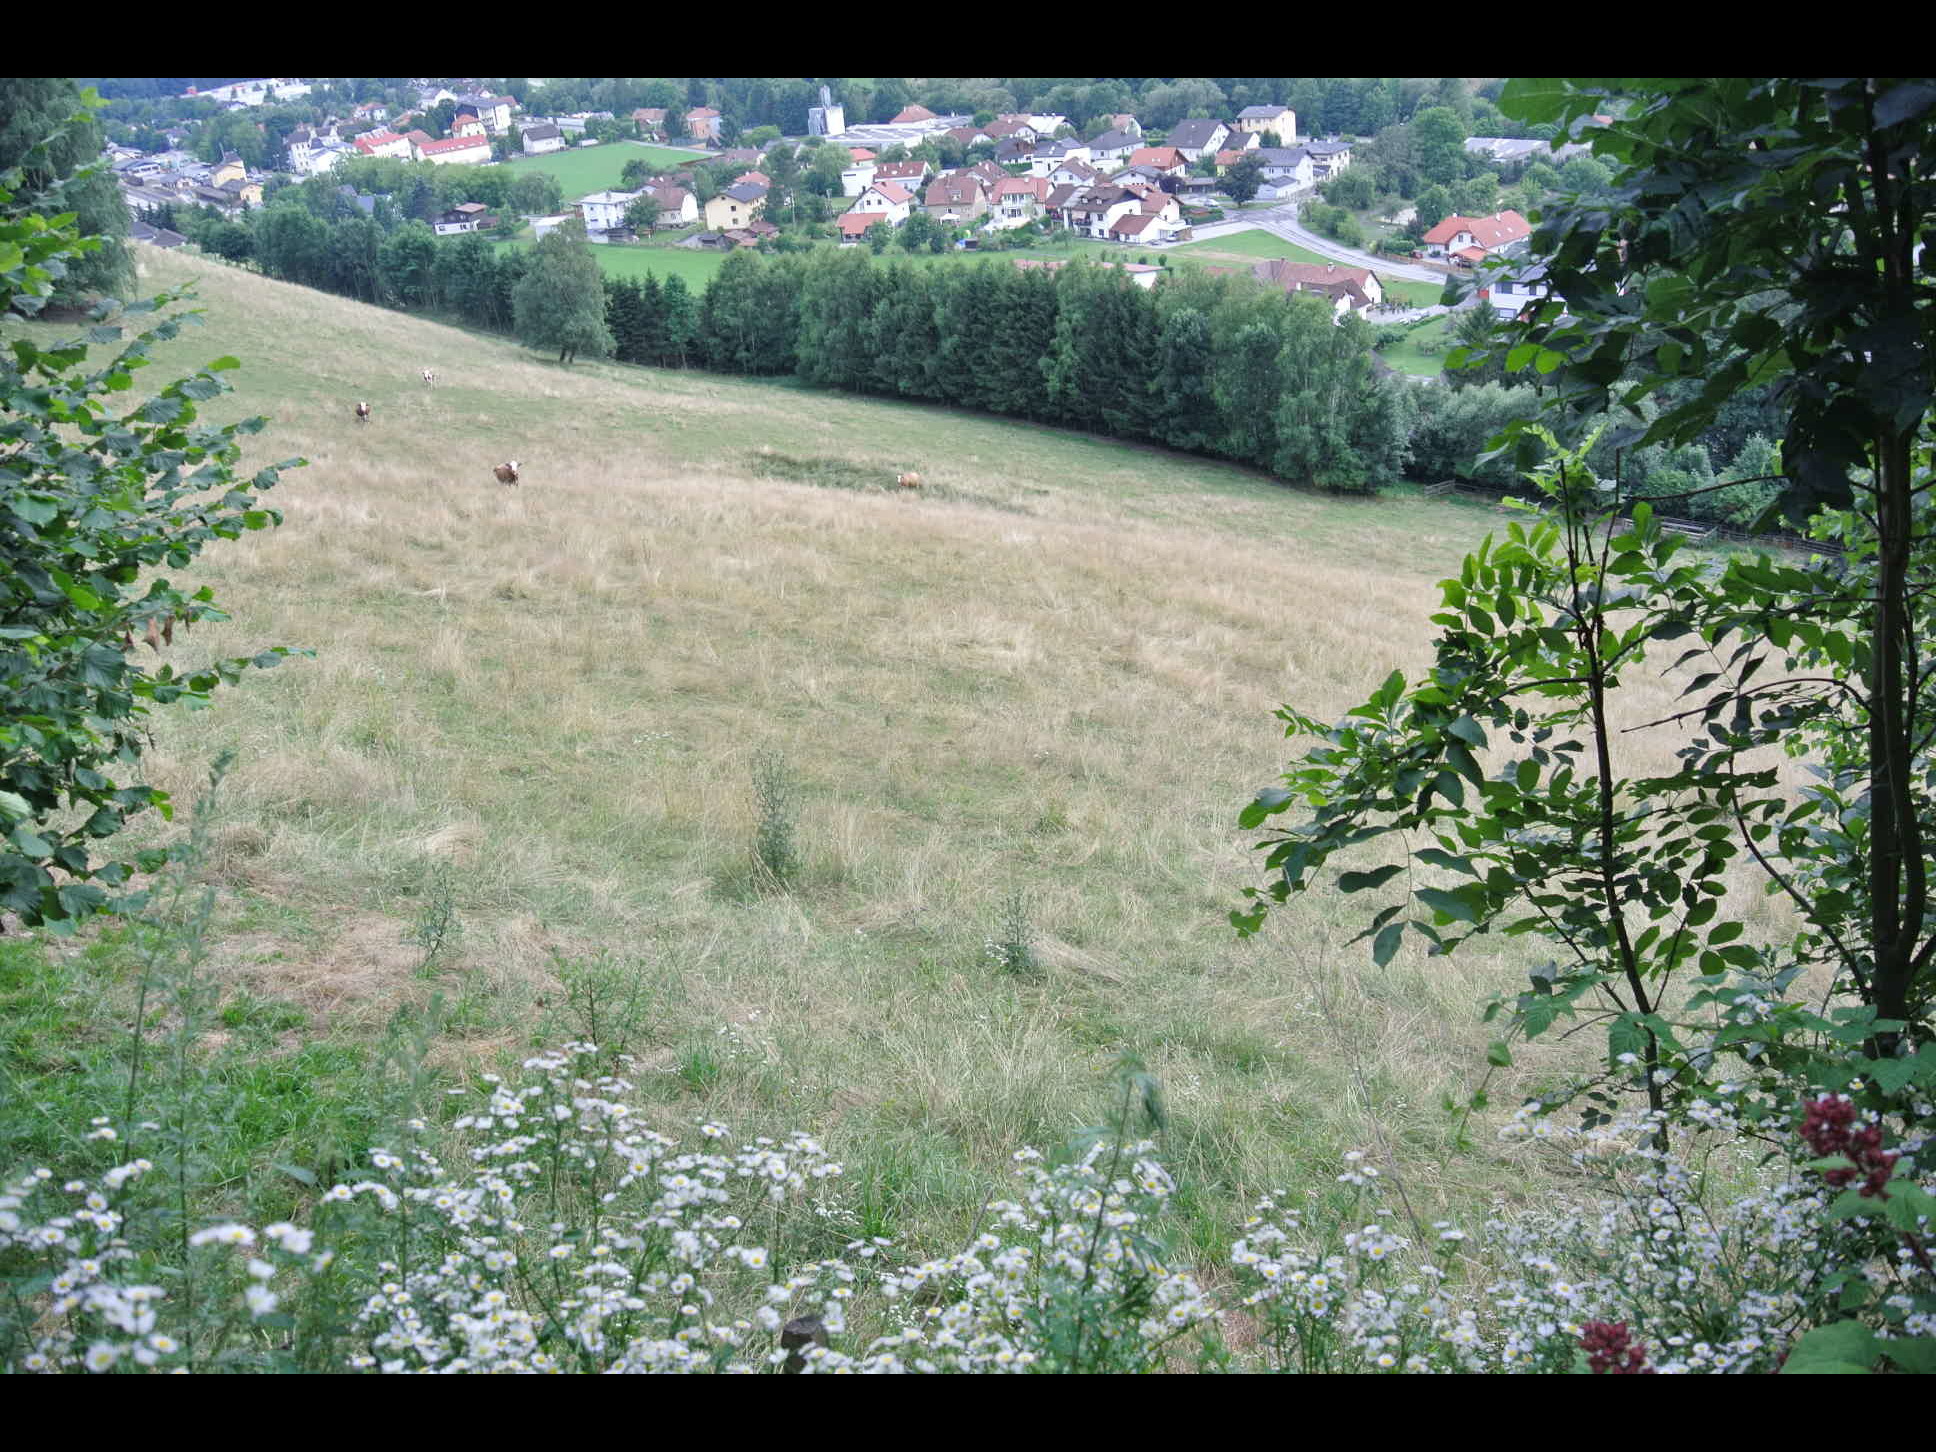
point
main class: Grassland
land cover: Grassland without tree/shrub cover
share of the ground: > 75 %
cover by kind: herbaceous plants 100 %
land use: Agriculture (excluding fallow land and kitchen gardens)
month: July
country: AT
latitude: 47.5671
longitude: 16.1038
